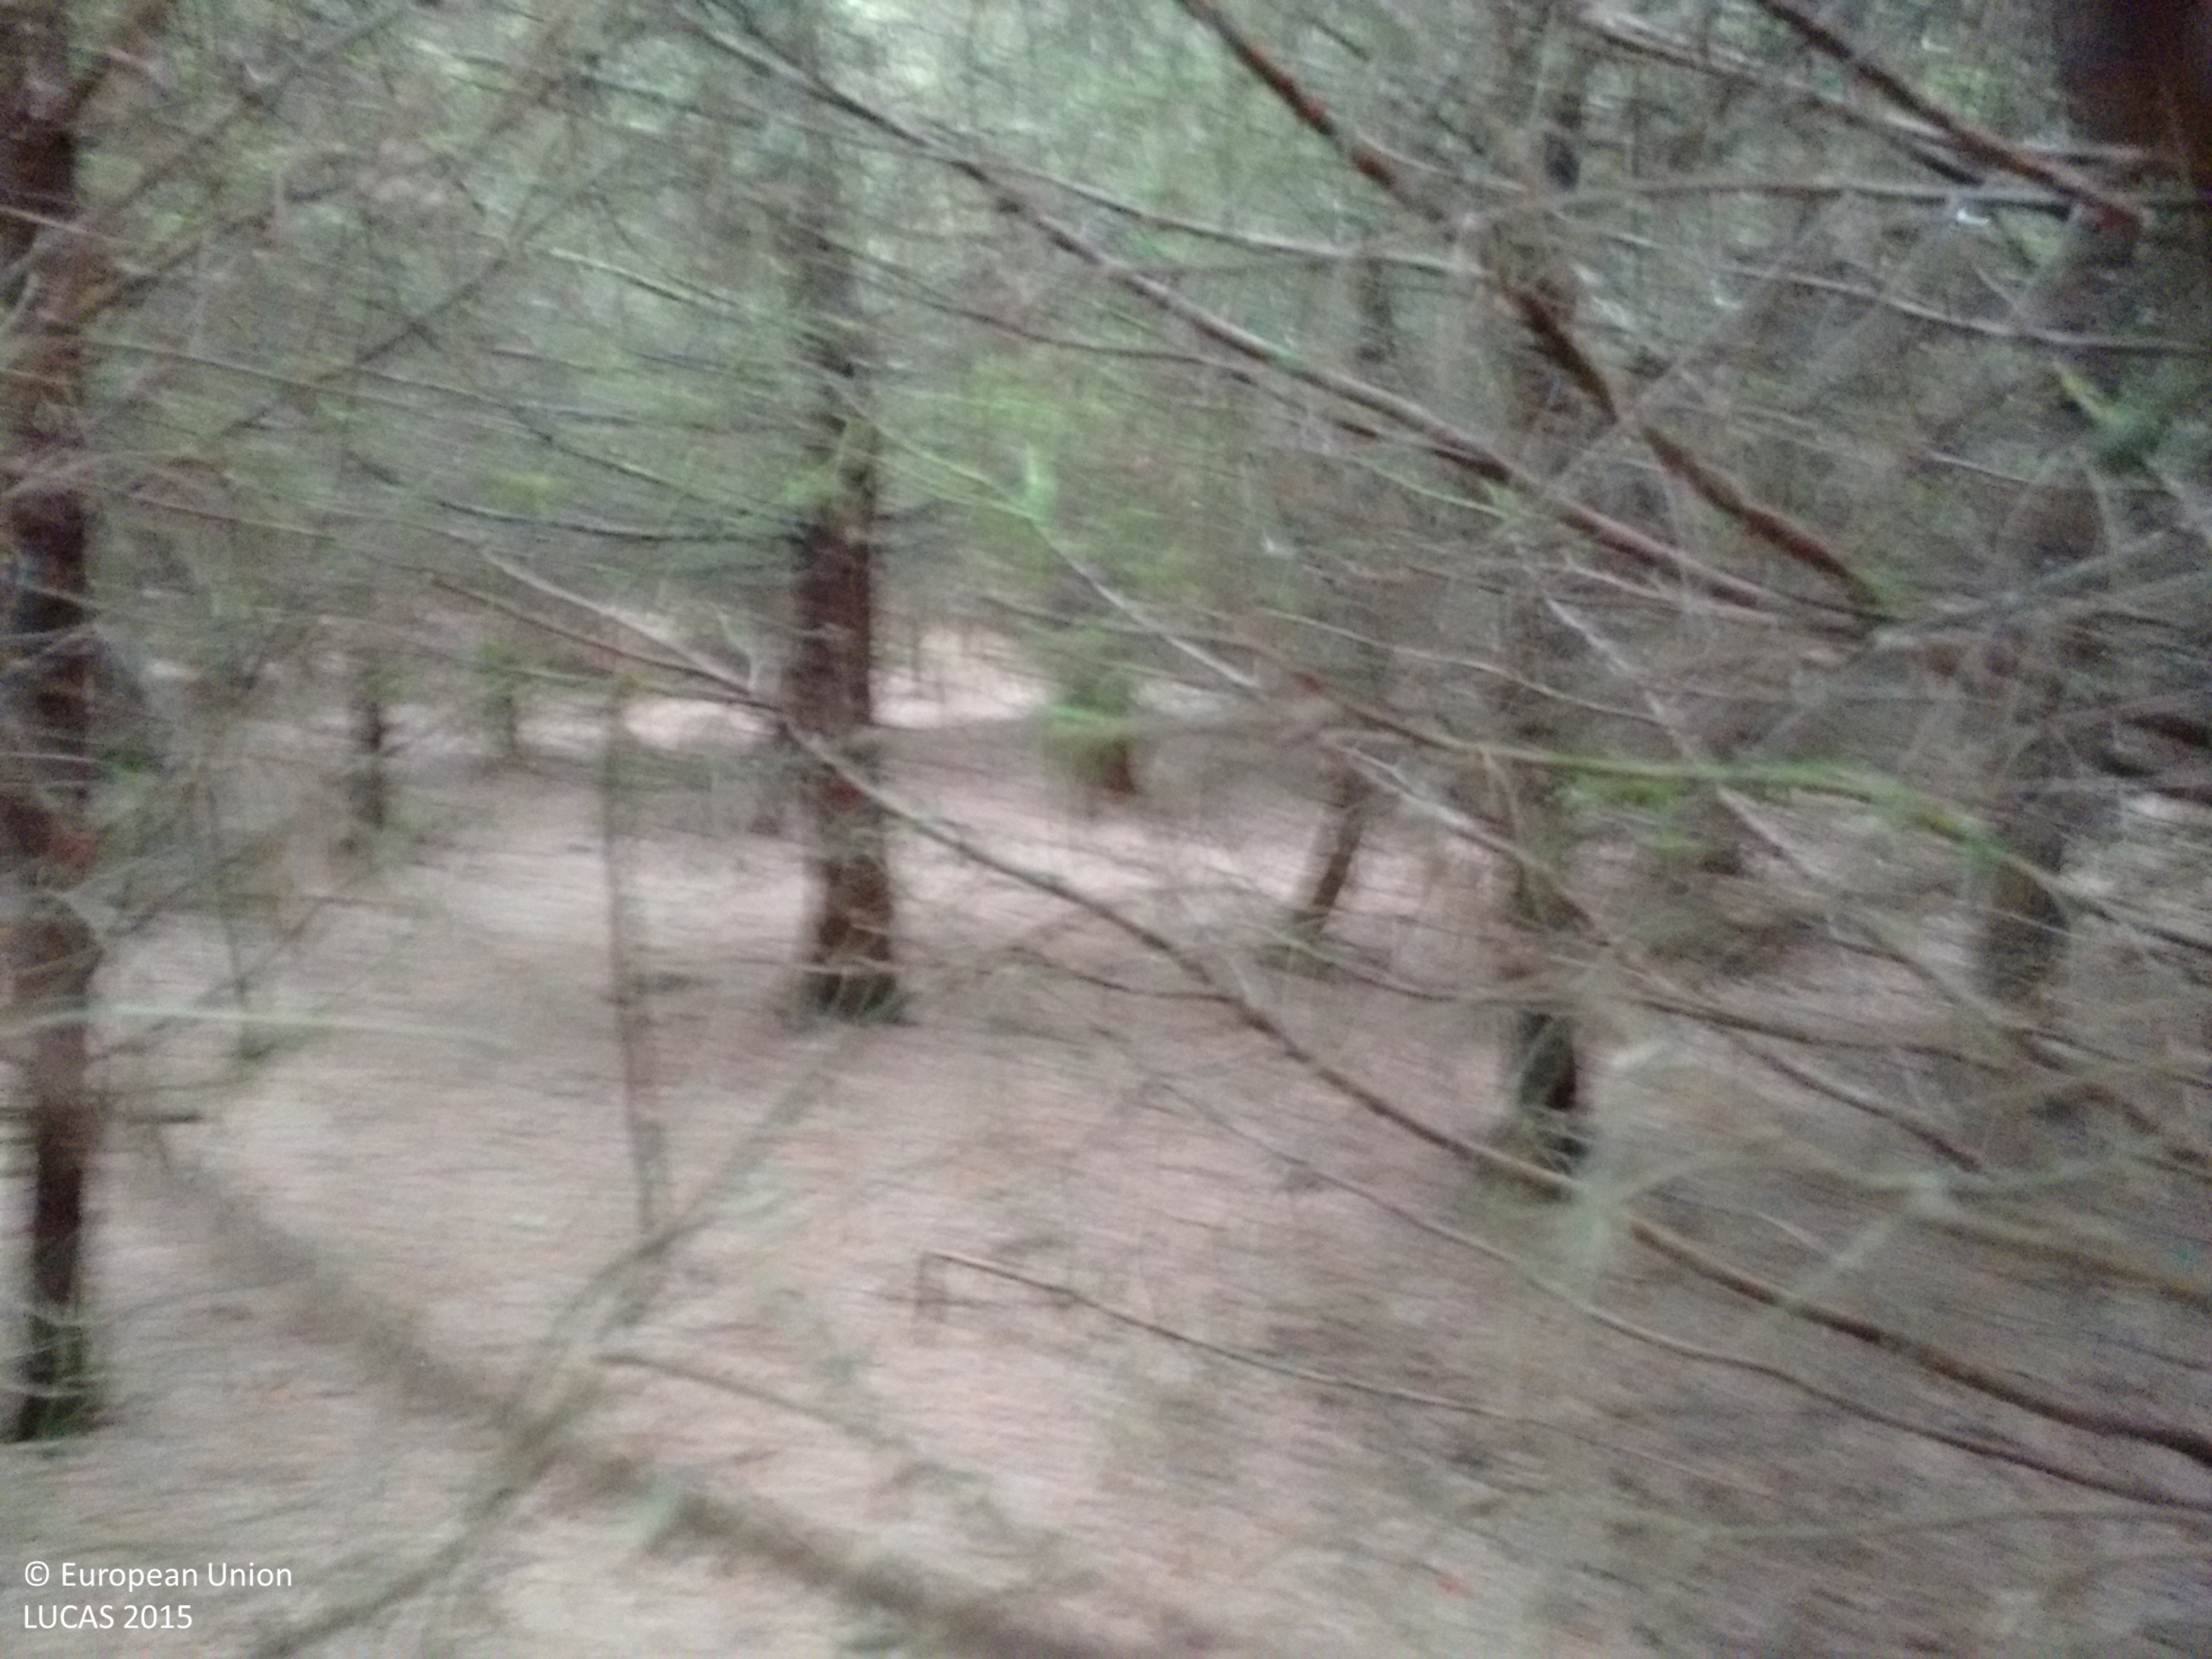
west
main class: Woodland
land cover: Spruce dominated coniferous woodland
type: exotic forest
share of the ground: > 75 %
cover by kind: coniferous forest trees 100 %
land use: Forestry
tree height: > 5 m
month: June
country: IE
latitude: 52.0310
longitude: -8.0327
